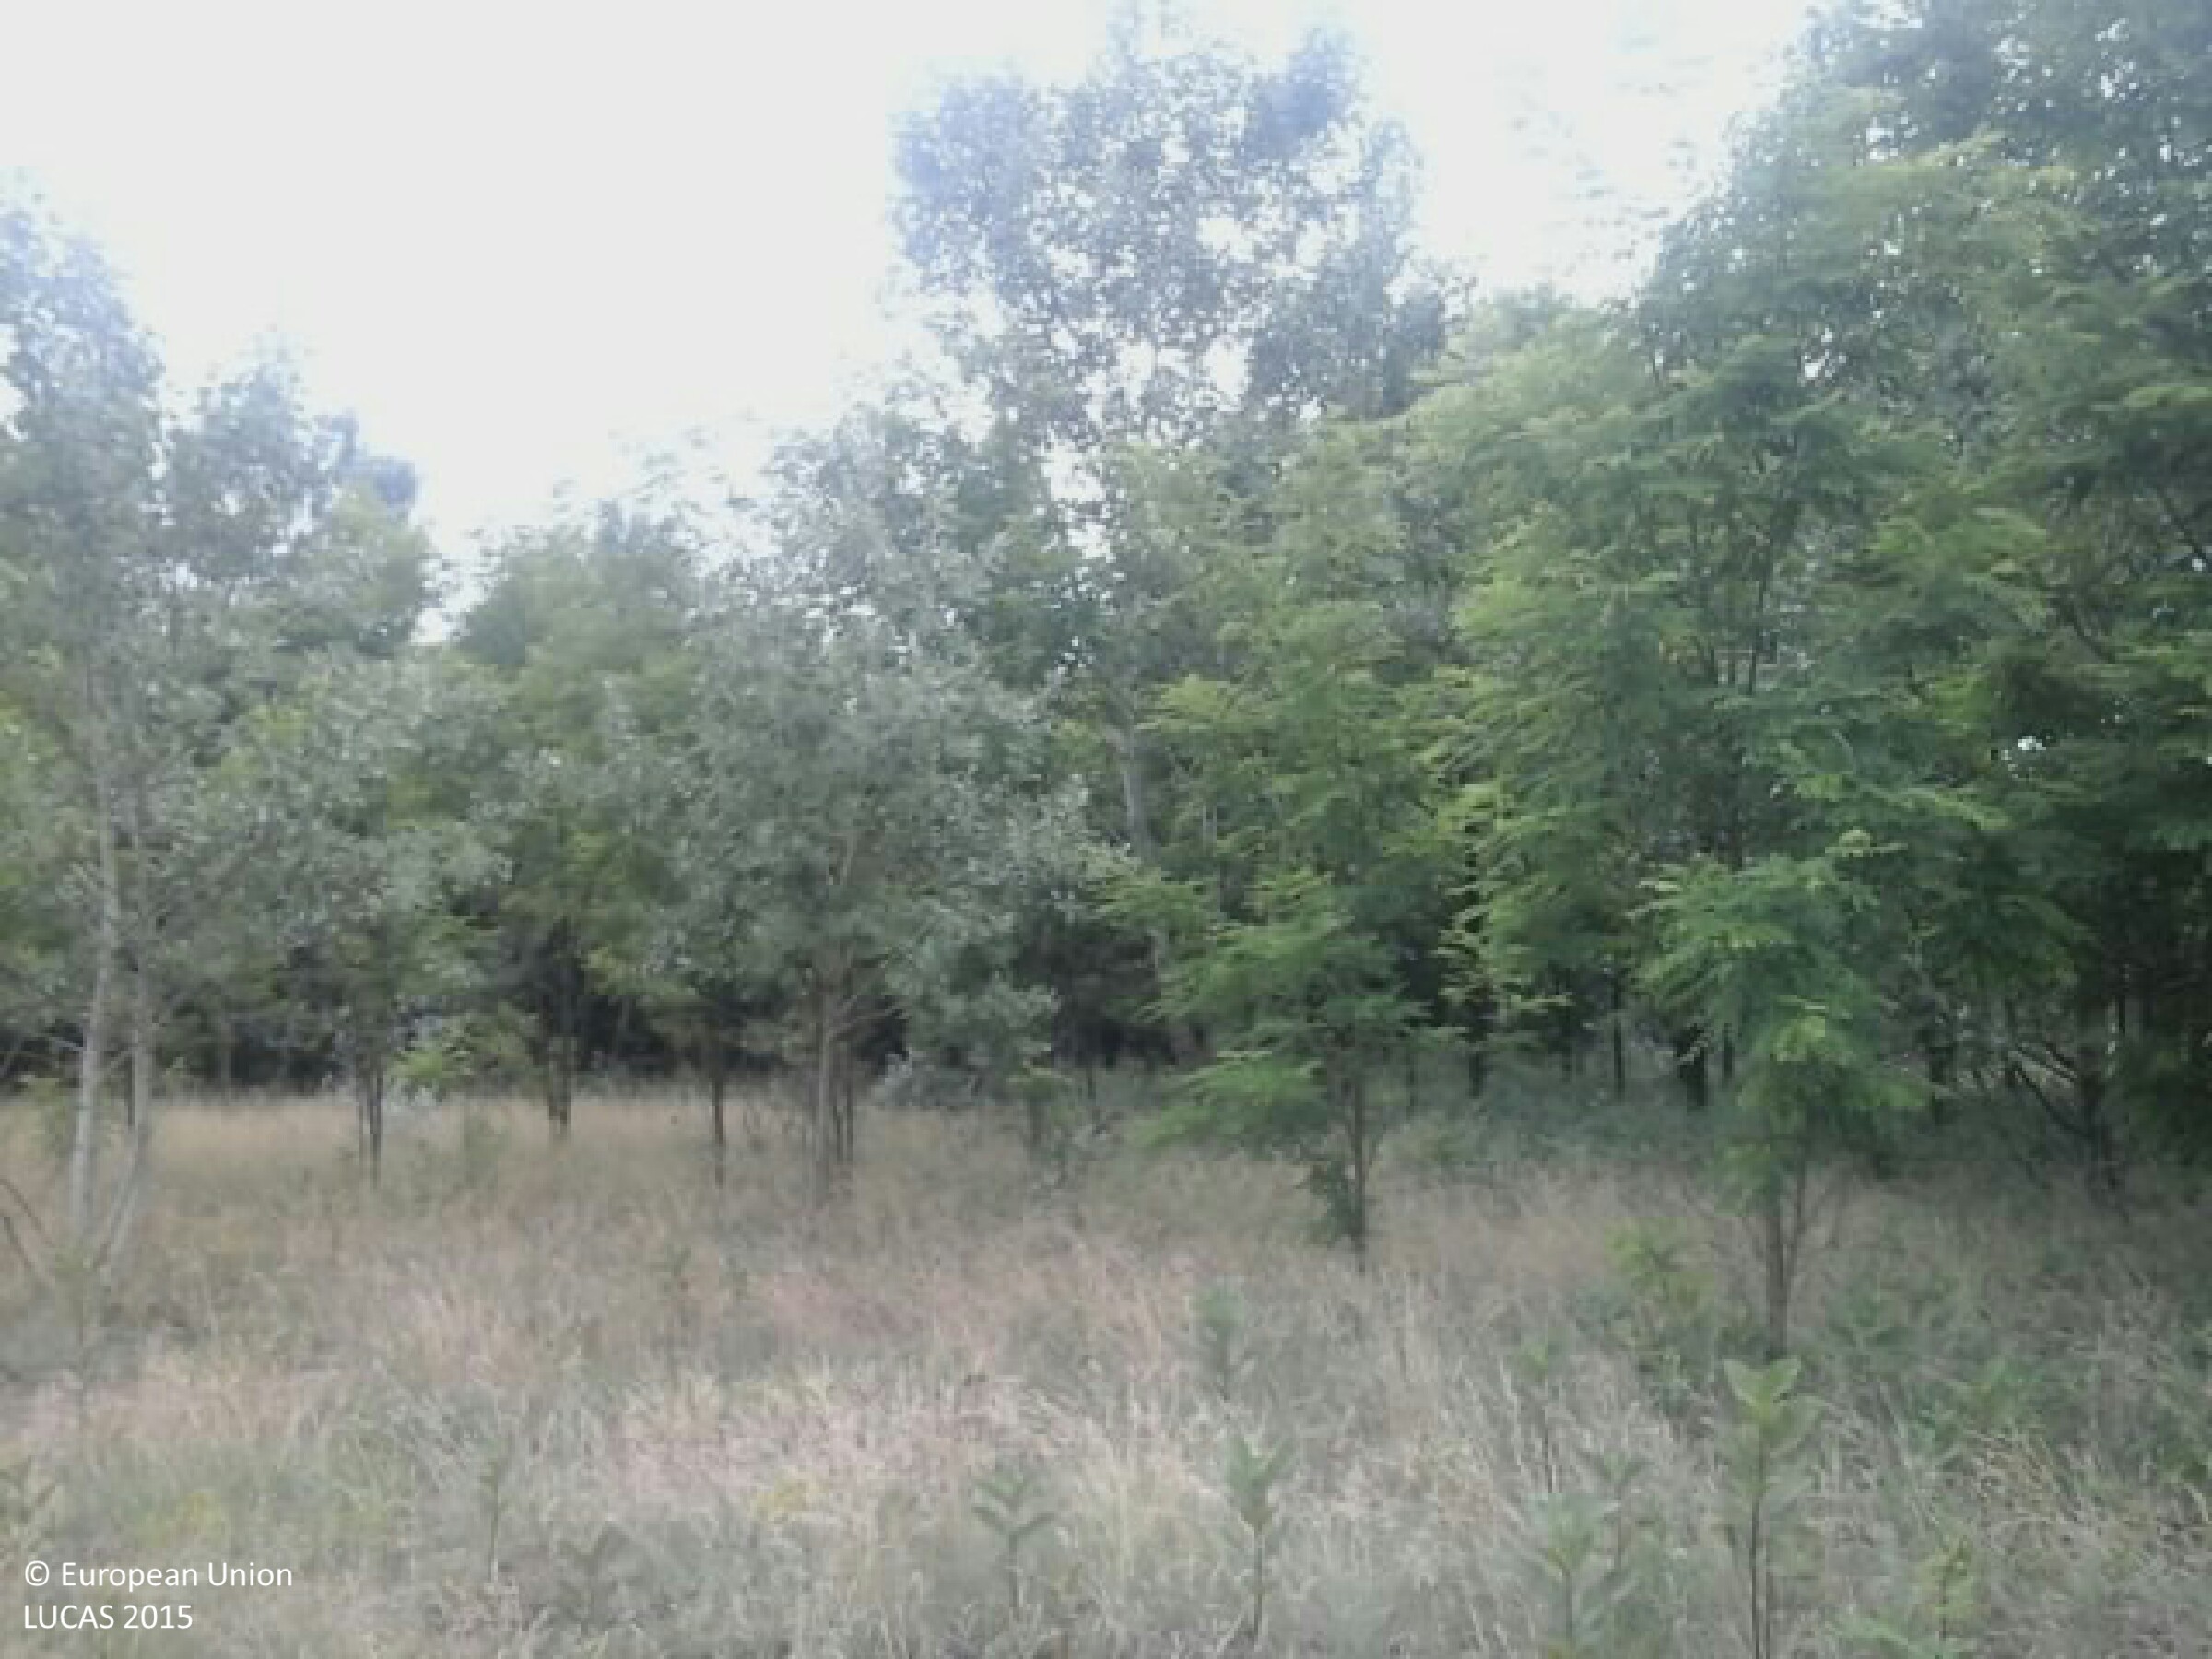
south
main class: Grassland
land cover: Grassland without tree/shrub cover
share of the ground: > 75 %
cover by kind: herbaceous plants 100 %
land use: Abandoned areas
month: June
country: HU
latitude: 46.7667
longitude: 19.6441
